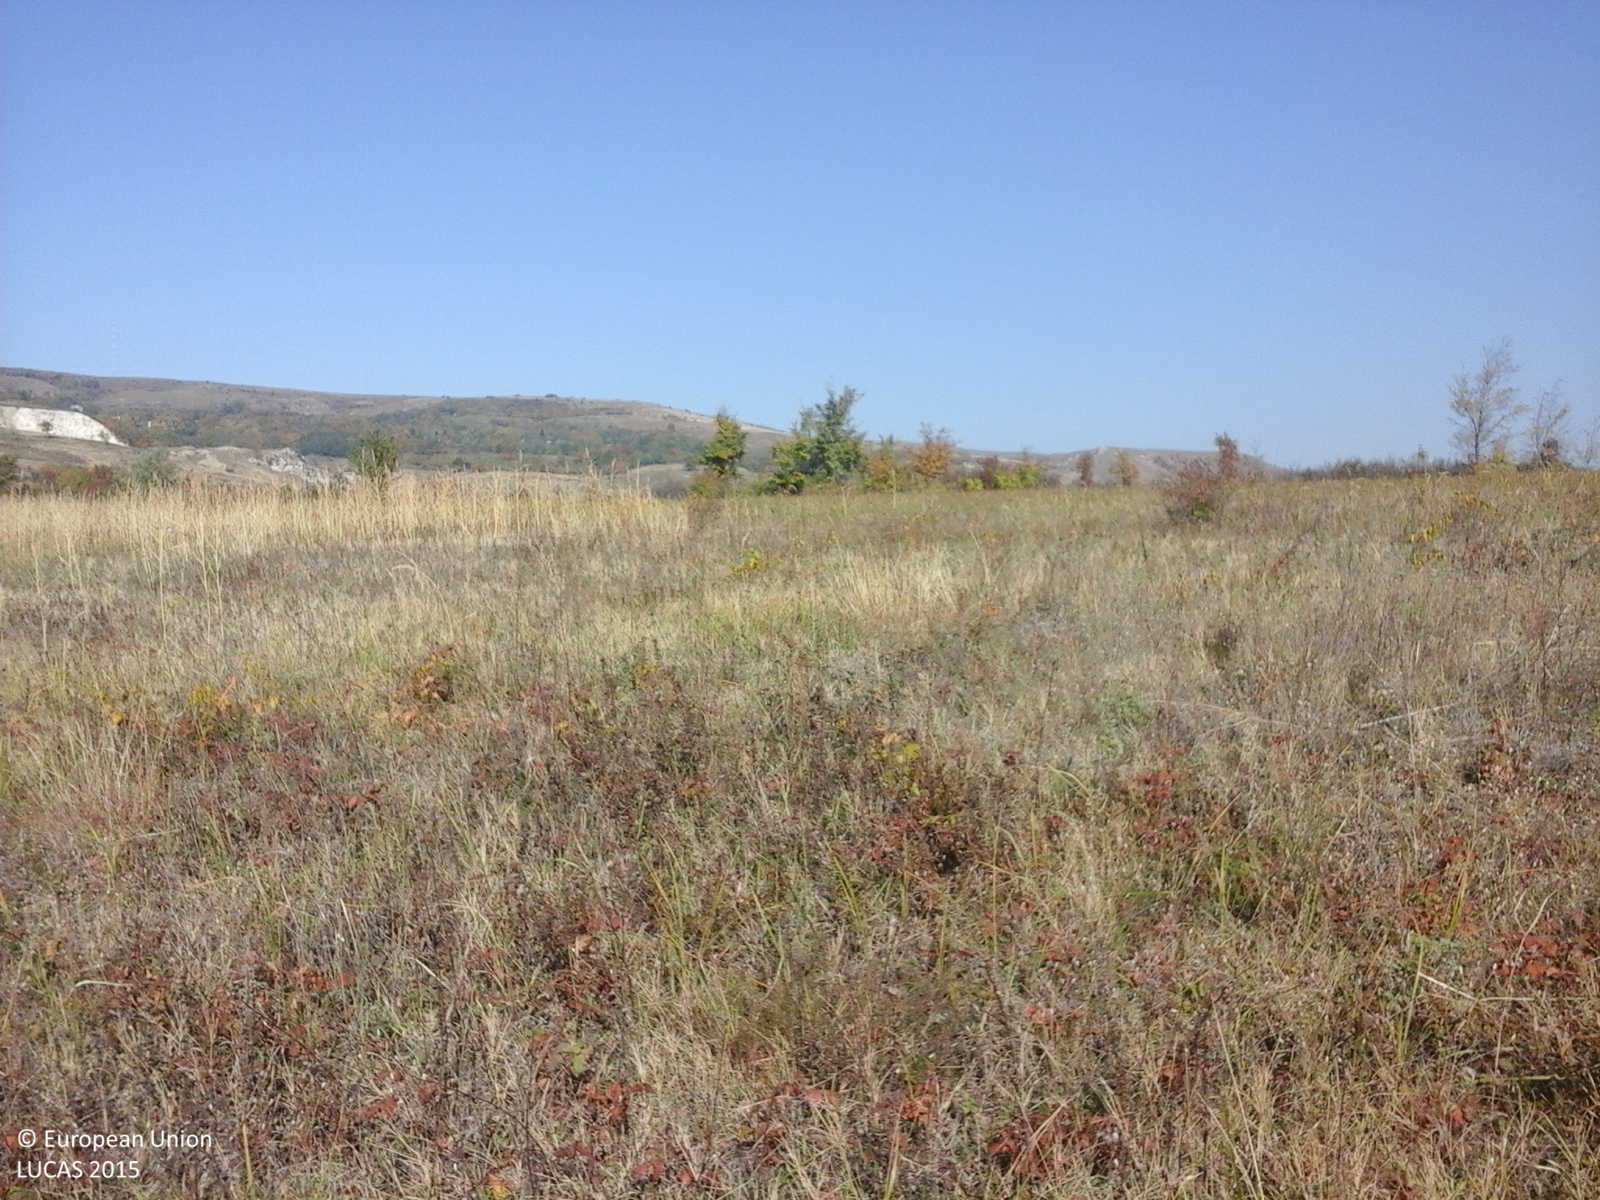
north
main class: Grassland
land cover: Grassland without tree/shrub cover
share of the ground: > 75 %
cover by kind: herbaceous plants 100 %
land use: Agriculture (excluding fallow land and kitchen gardens)
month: October
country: RO
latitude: 45.0855
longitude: 26.4458
